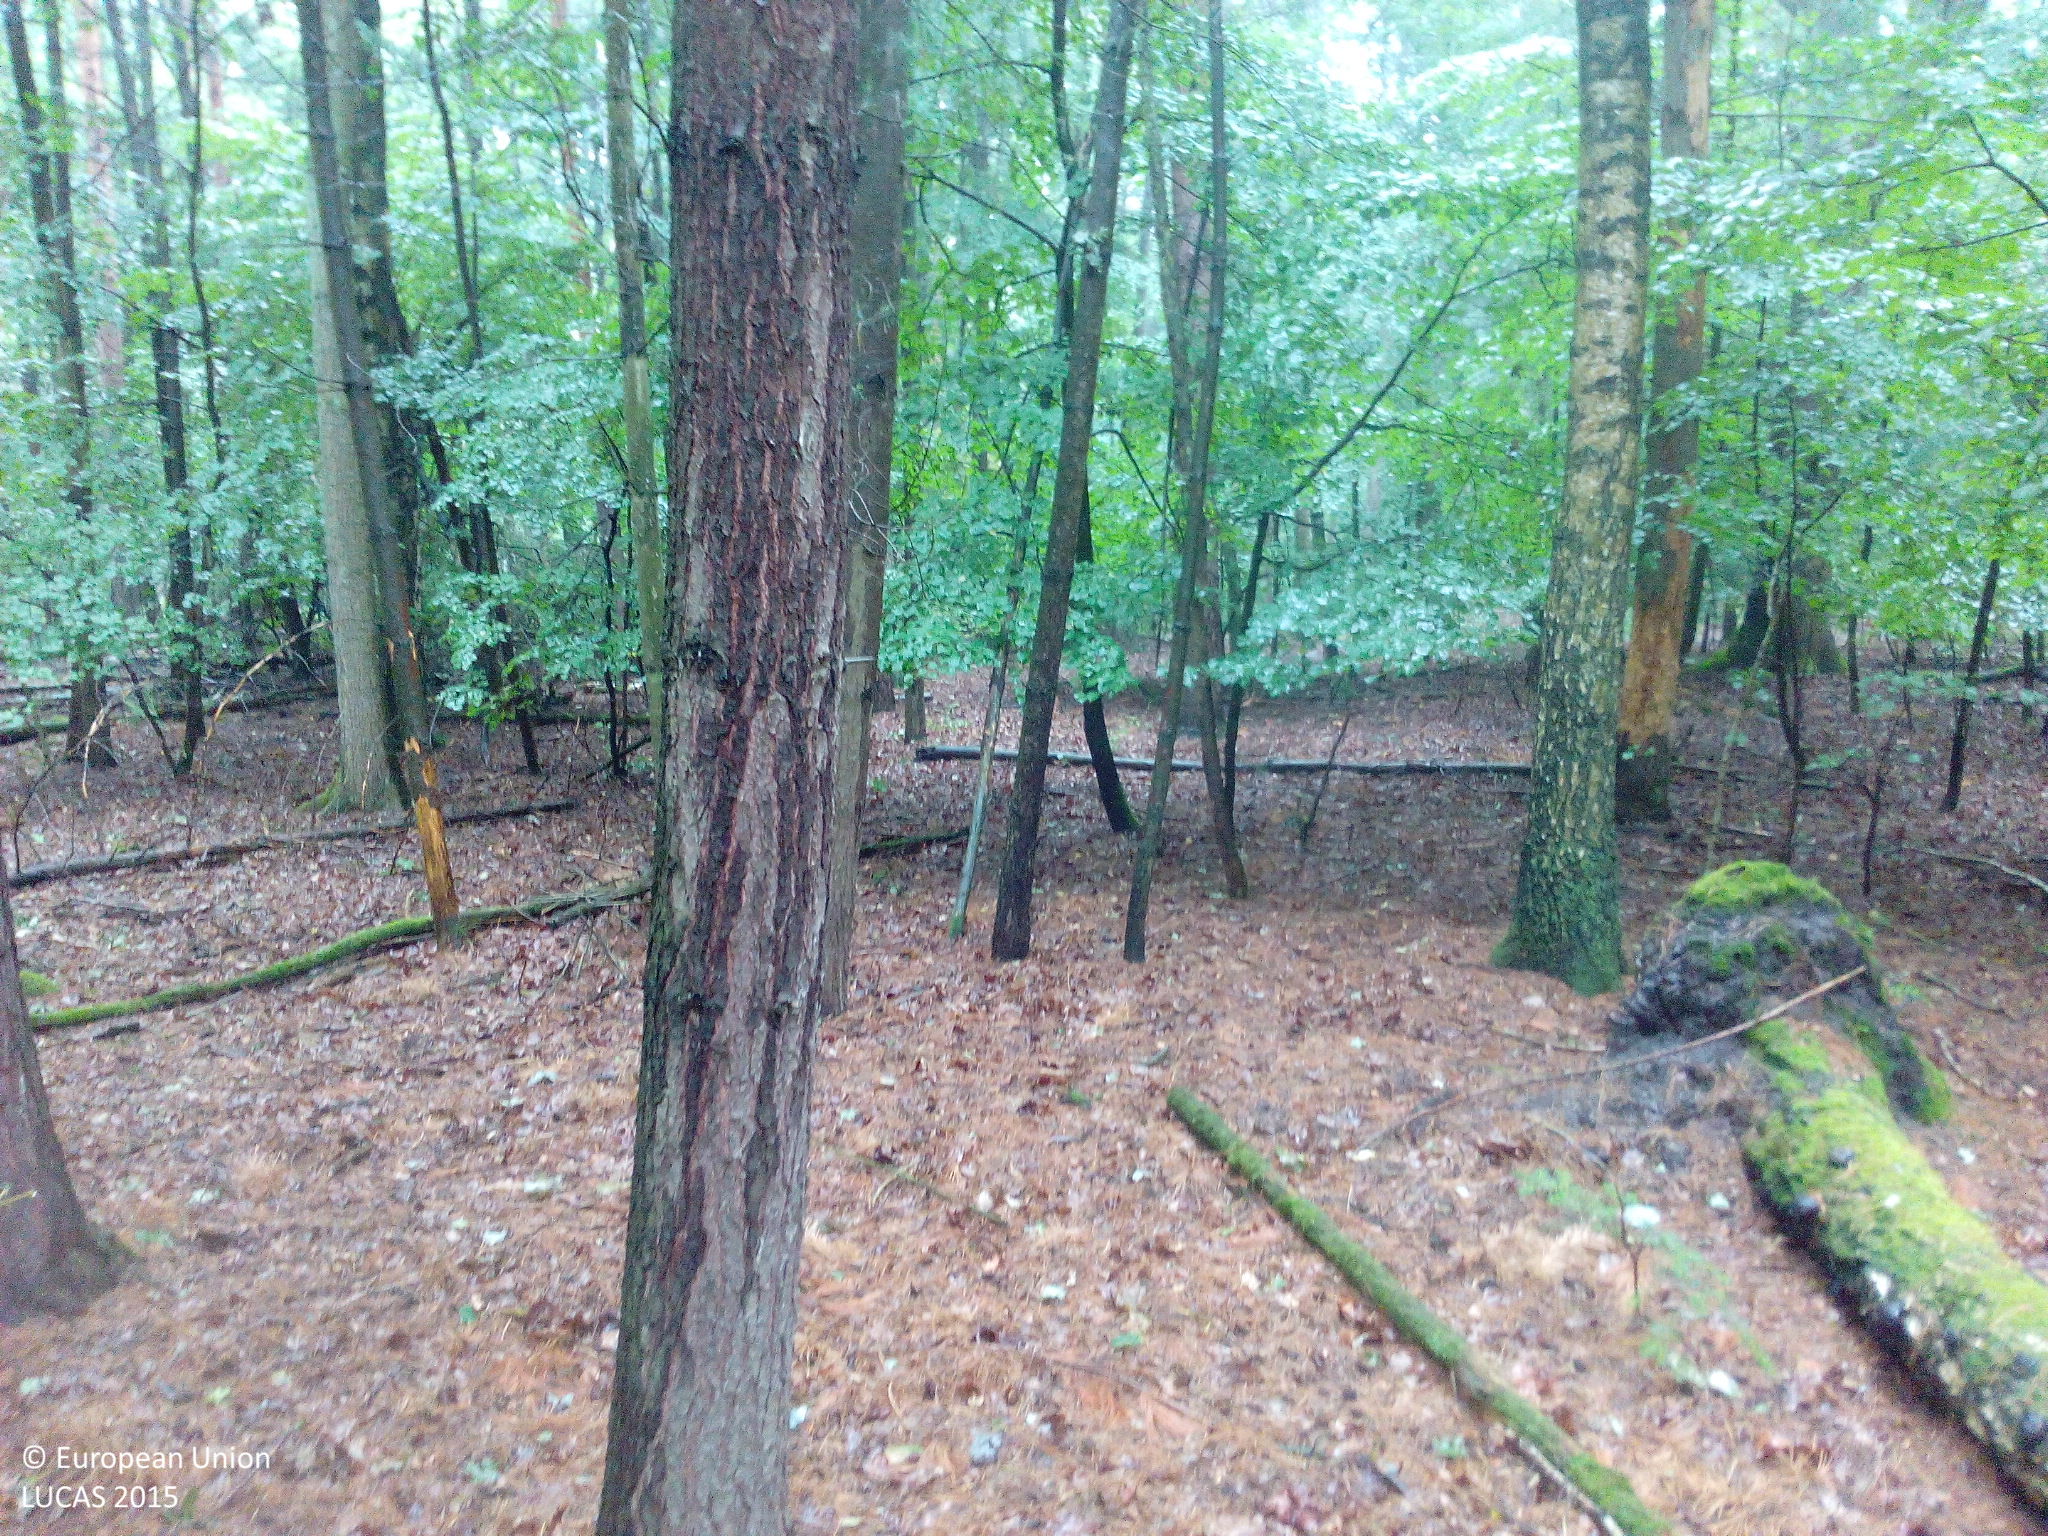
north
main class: Woodland
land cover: Pine dominated mixed woodland
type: hemiboreal forest and nemoral coniferous forest and mixed broadleaved-coniferous forest
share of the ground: > 75 %
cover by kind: coniferous forest trees 65 %, broadleaved forest trees 25 %, herbaceous plants 5 %, lichens and mosses 5 %
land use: Forestry
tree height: > 5 m
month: July
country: DE
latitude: 52.5869
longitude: 13.1733
